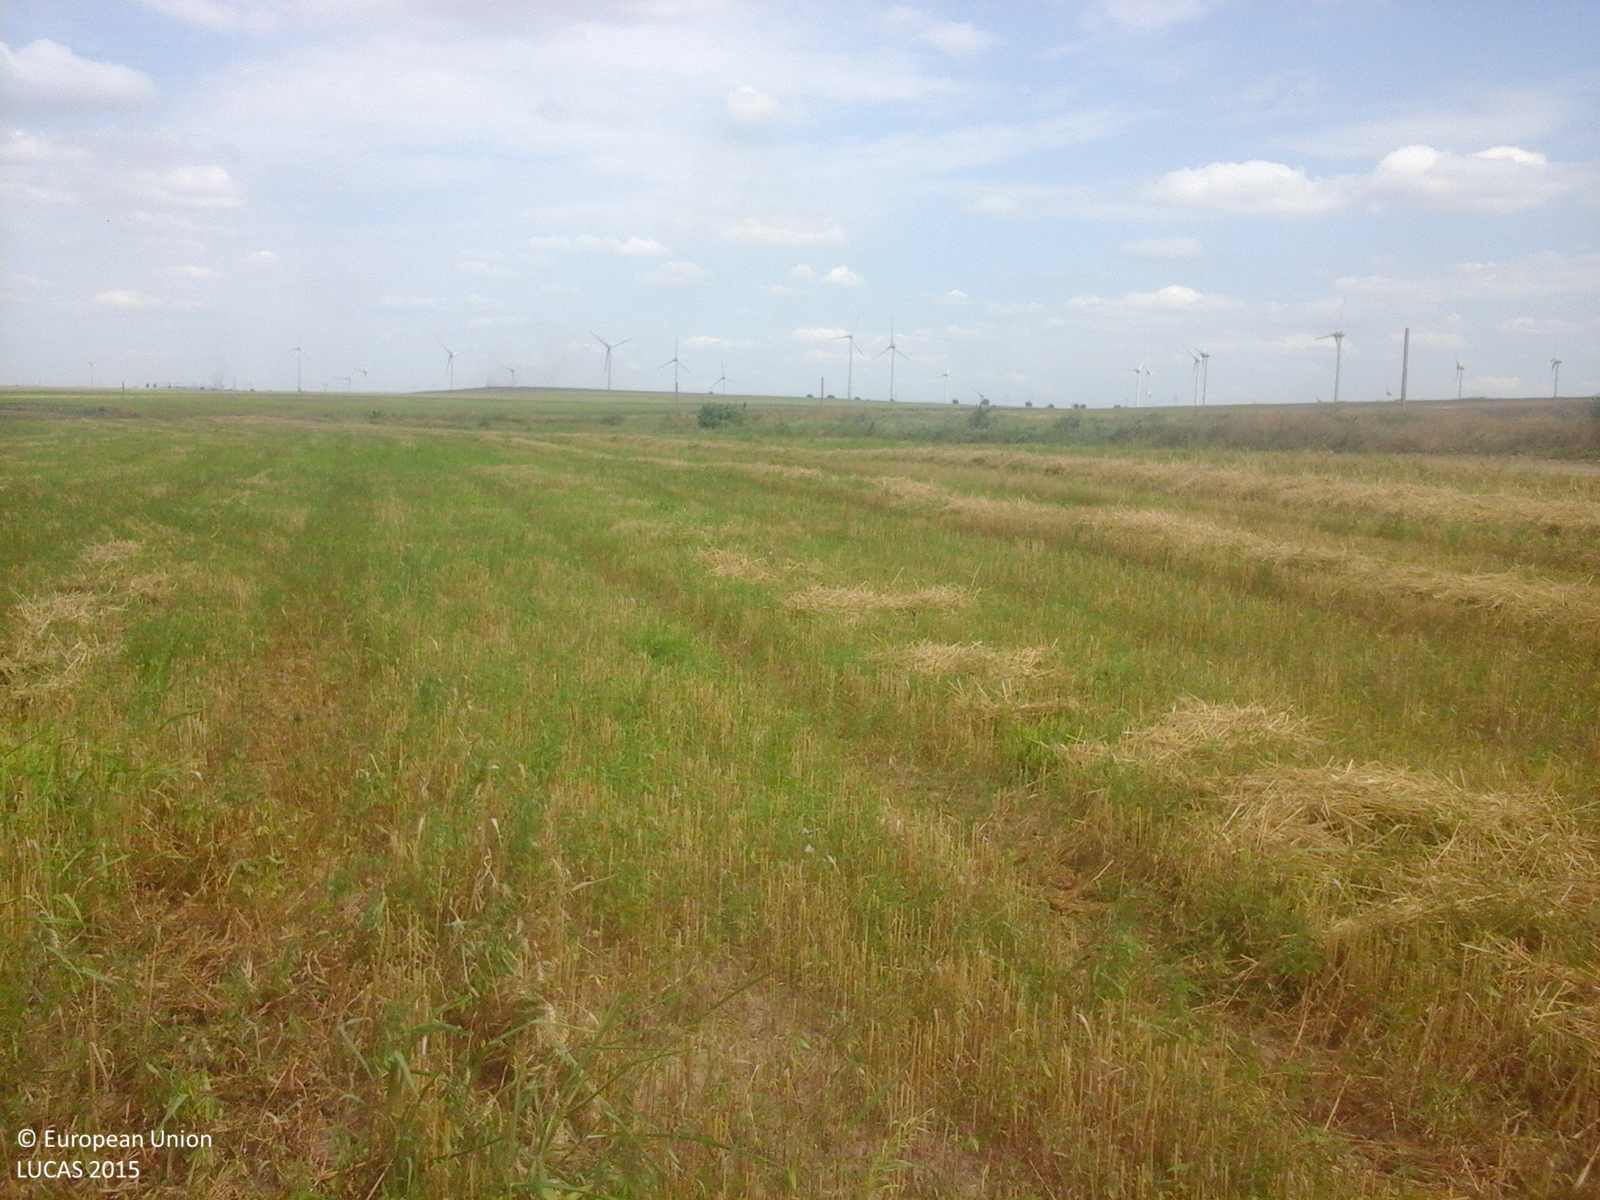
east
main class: Cropland
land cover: Common wheat
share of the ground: 25 - 50 %
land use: Agriculture (excluding fallow land and kitchen gardens)
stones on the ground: < 10 %
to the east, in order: Common wheat; Tracks; Grass margins; Ditches and canals; Grass margins; Tracks; Other bare soil
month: August
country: RO
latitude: 44.7727
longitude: 28.1989
